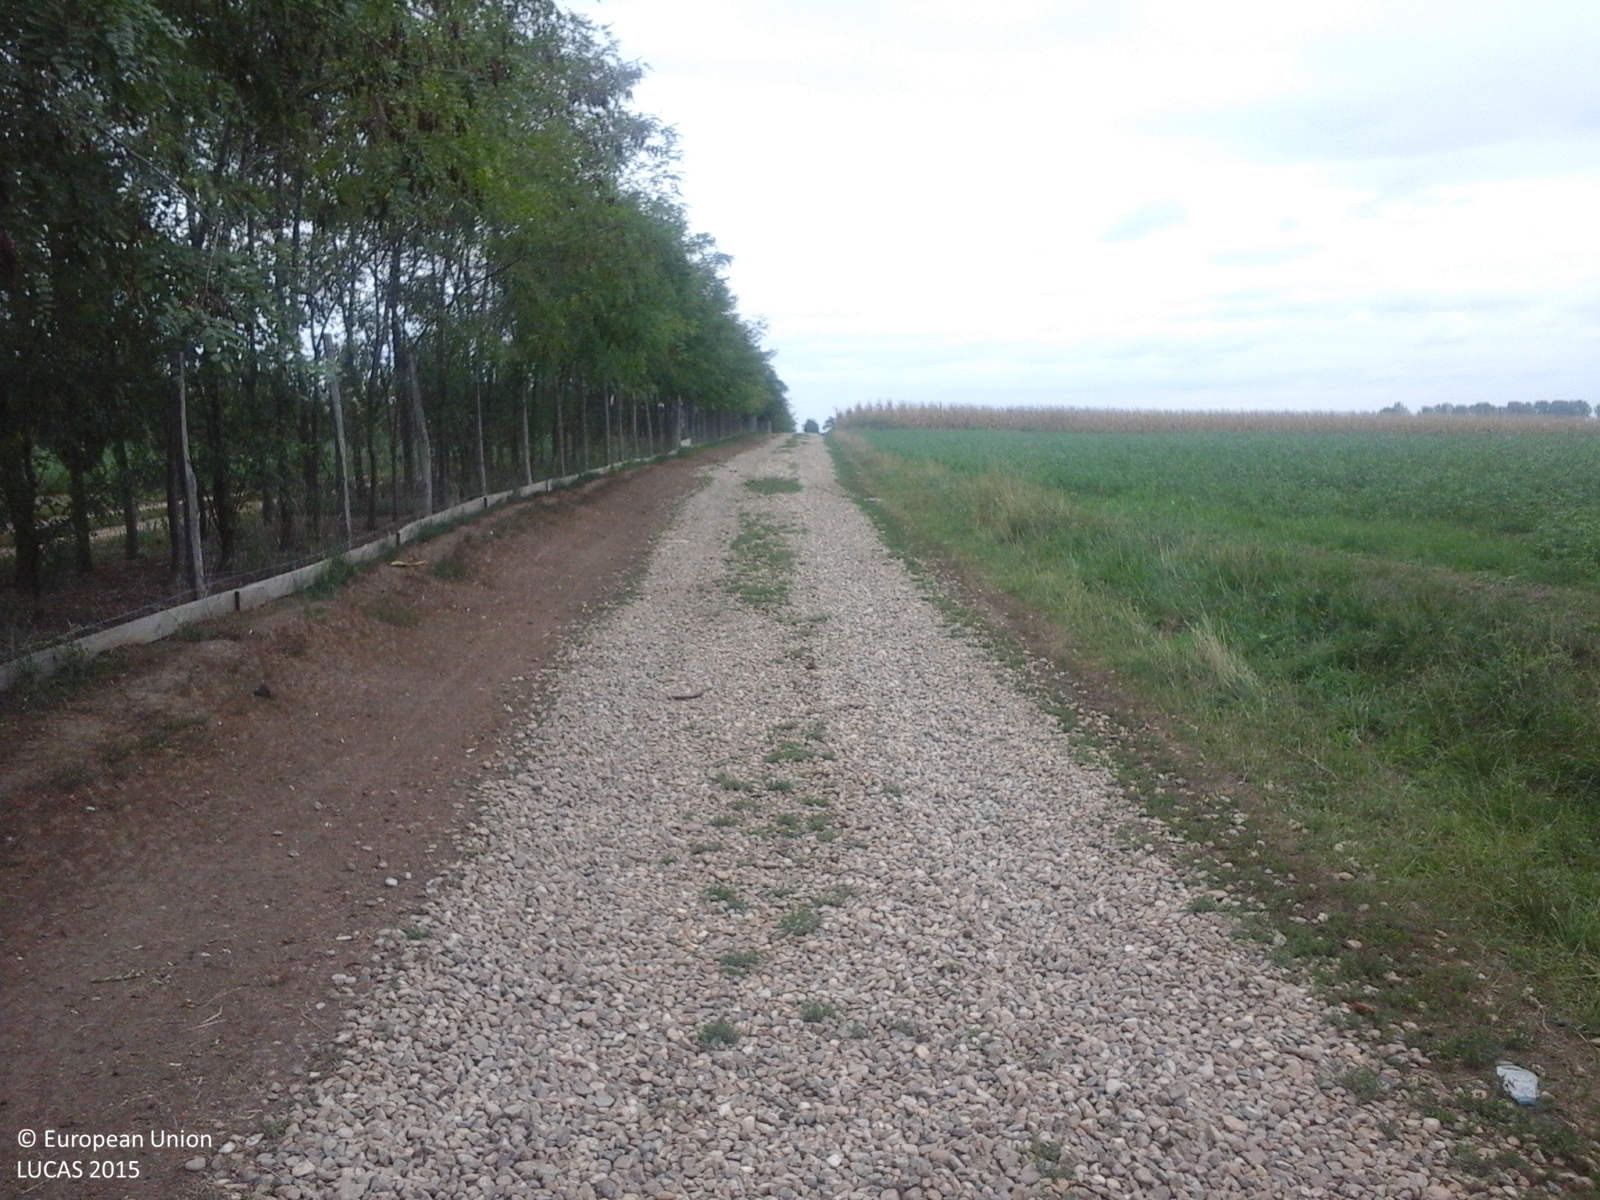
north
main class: Cropland
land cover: Cherry fruit
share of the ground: 50 - 75 %
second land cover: Grassland without tree/shrub cover
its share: > 75 %
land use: Agriculture (excluding fallow land and kitchen gardens)
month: September
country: RO
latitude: 47.3439
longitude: 22.0279
